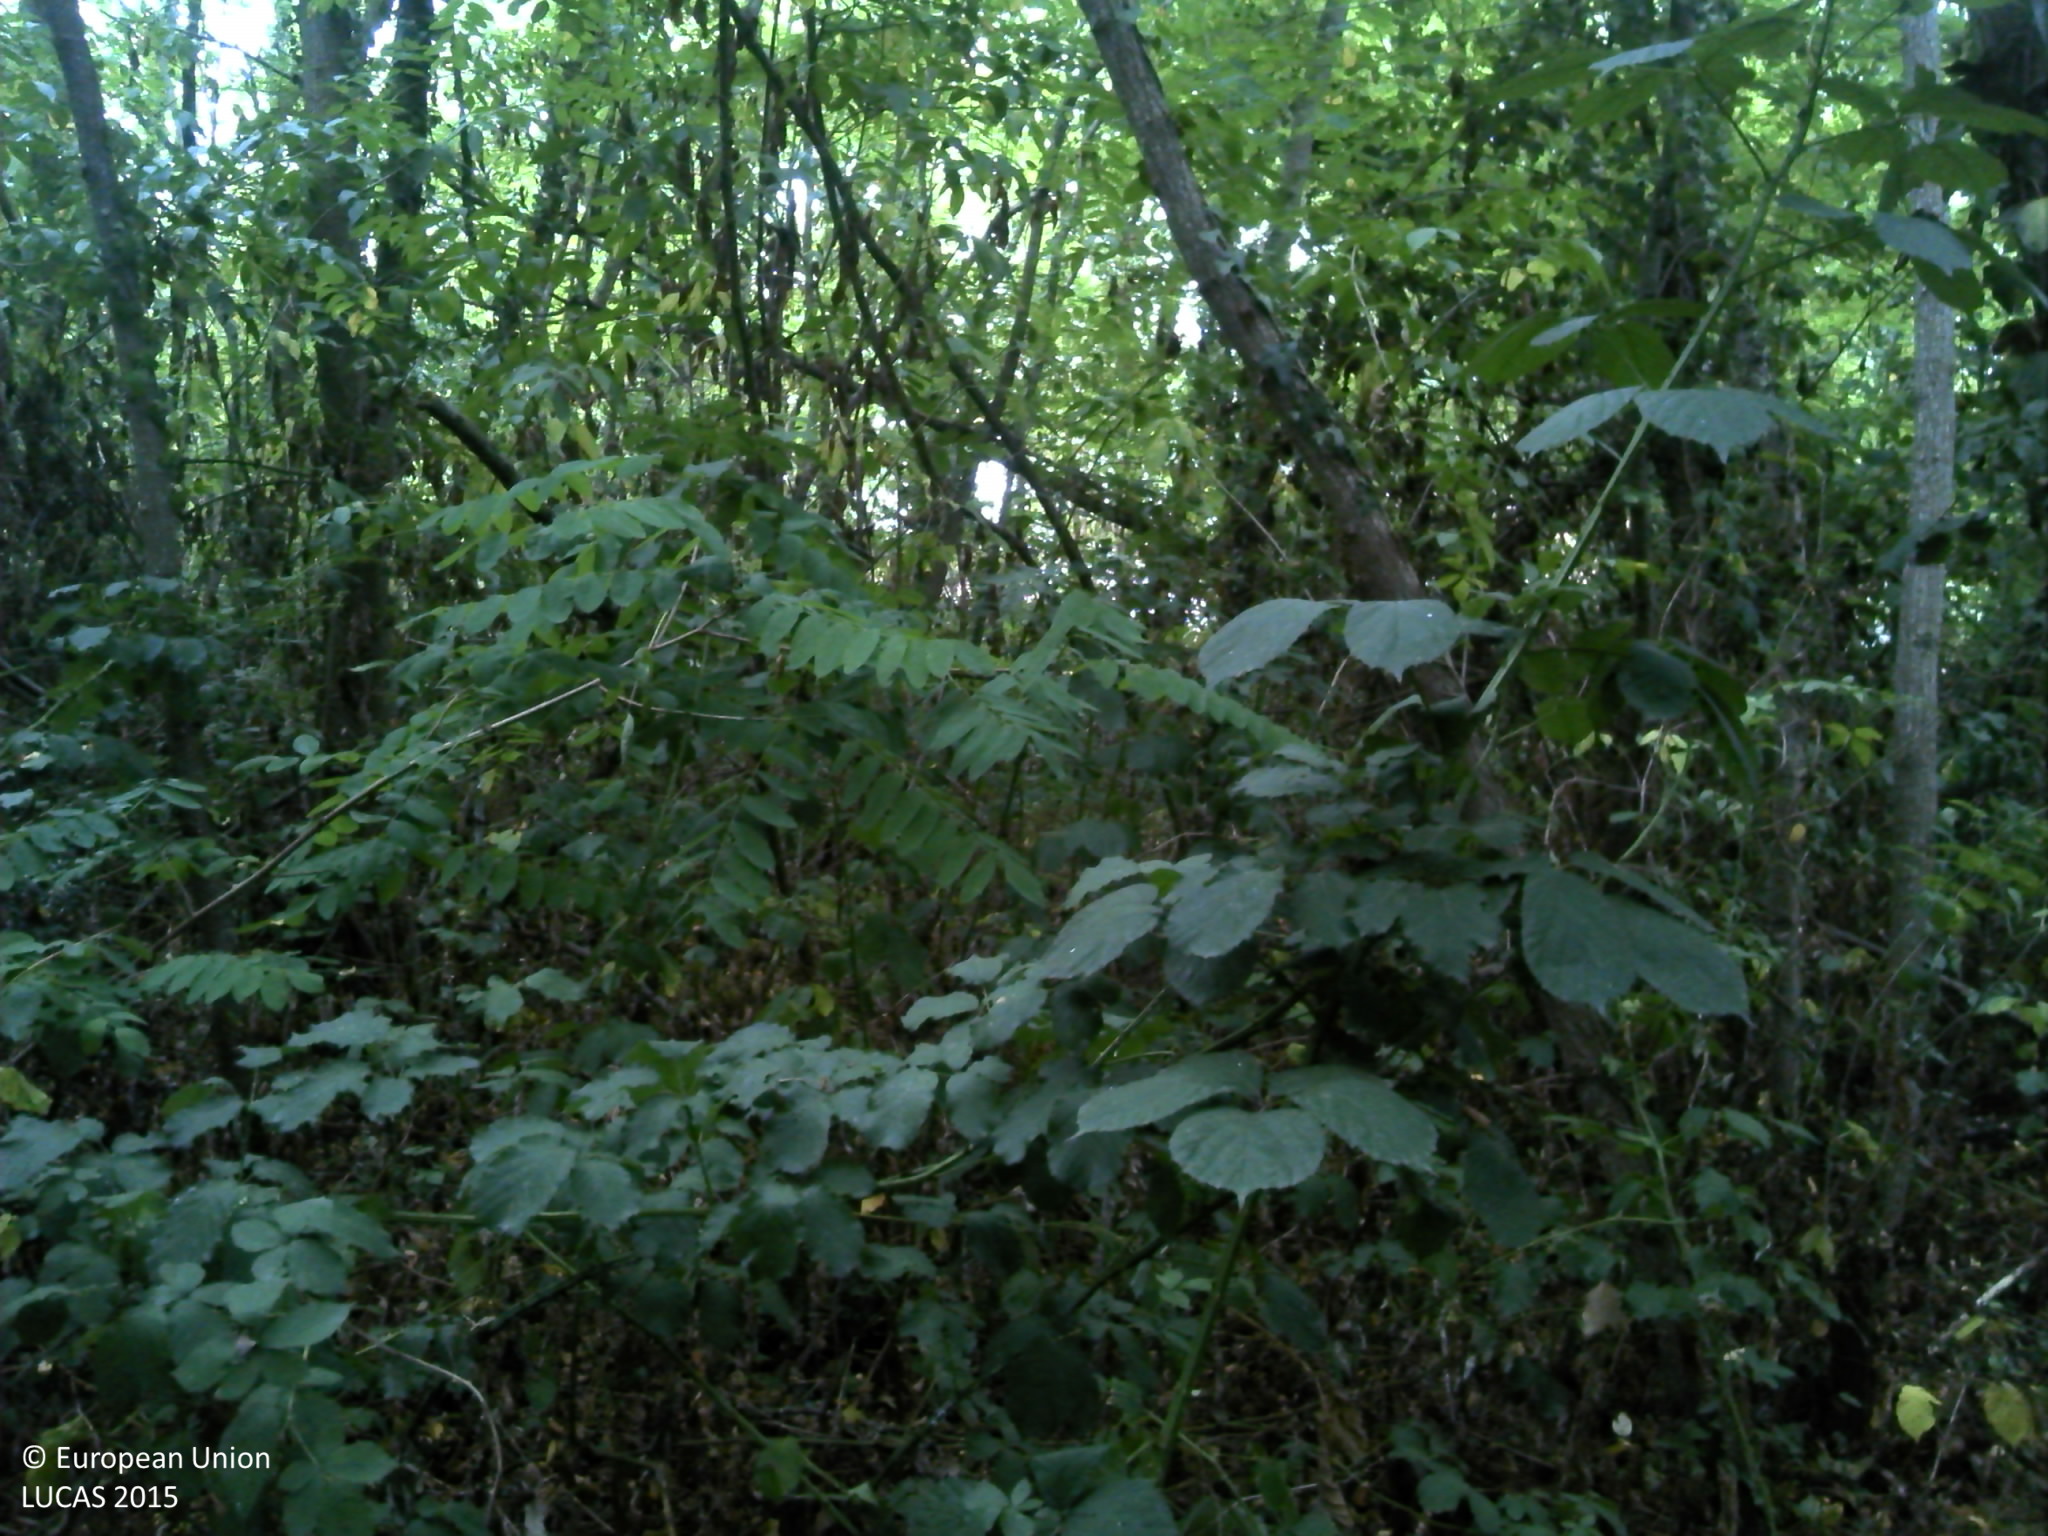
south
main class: Woodland
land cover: Broadleaved woodland
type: acidophilous oak and oak-birch forest
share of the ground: > 75 %
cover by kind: broadleaved forest trees 60 %, shrubs 30 %, herbaceous plants 5 %, lichens and mosses 5 %
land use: Semi-natural and natural areas not in use
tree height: > 5 m
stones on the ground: 10 - 25 %
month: July
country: FR
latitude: 44.6553
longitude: -0.4706
